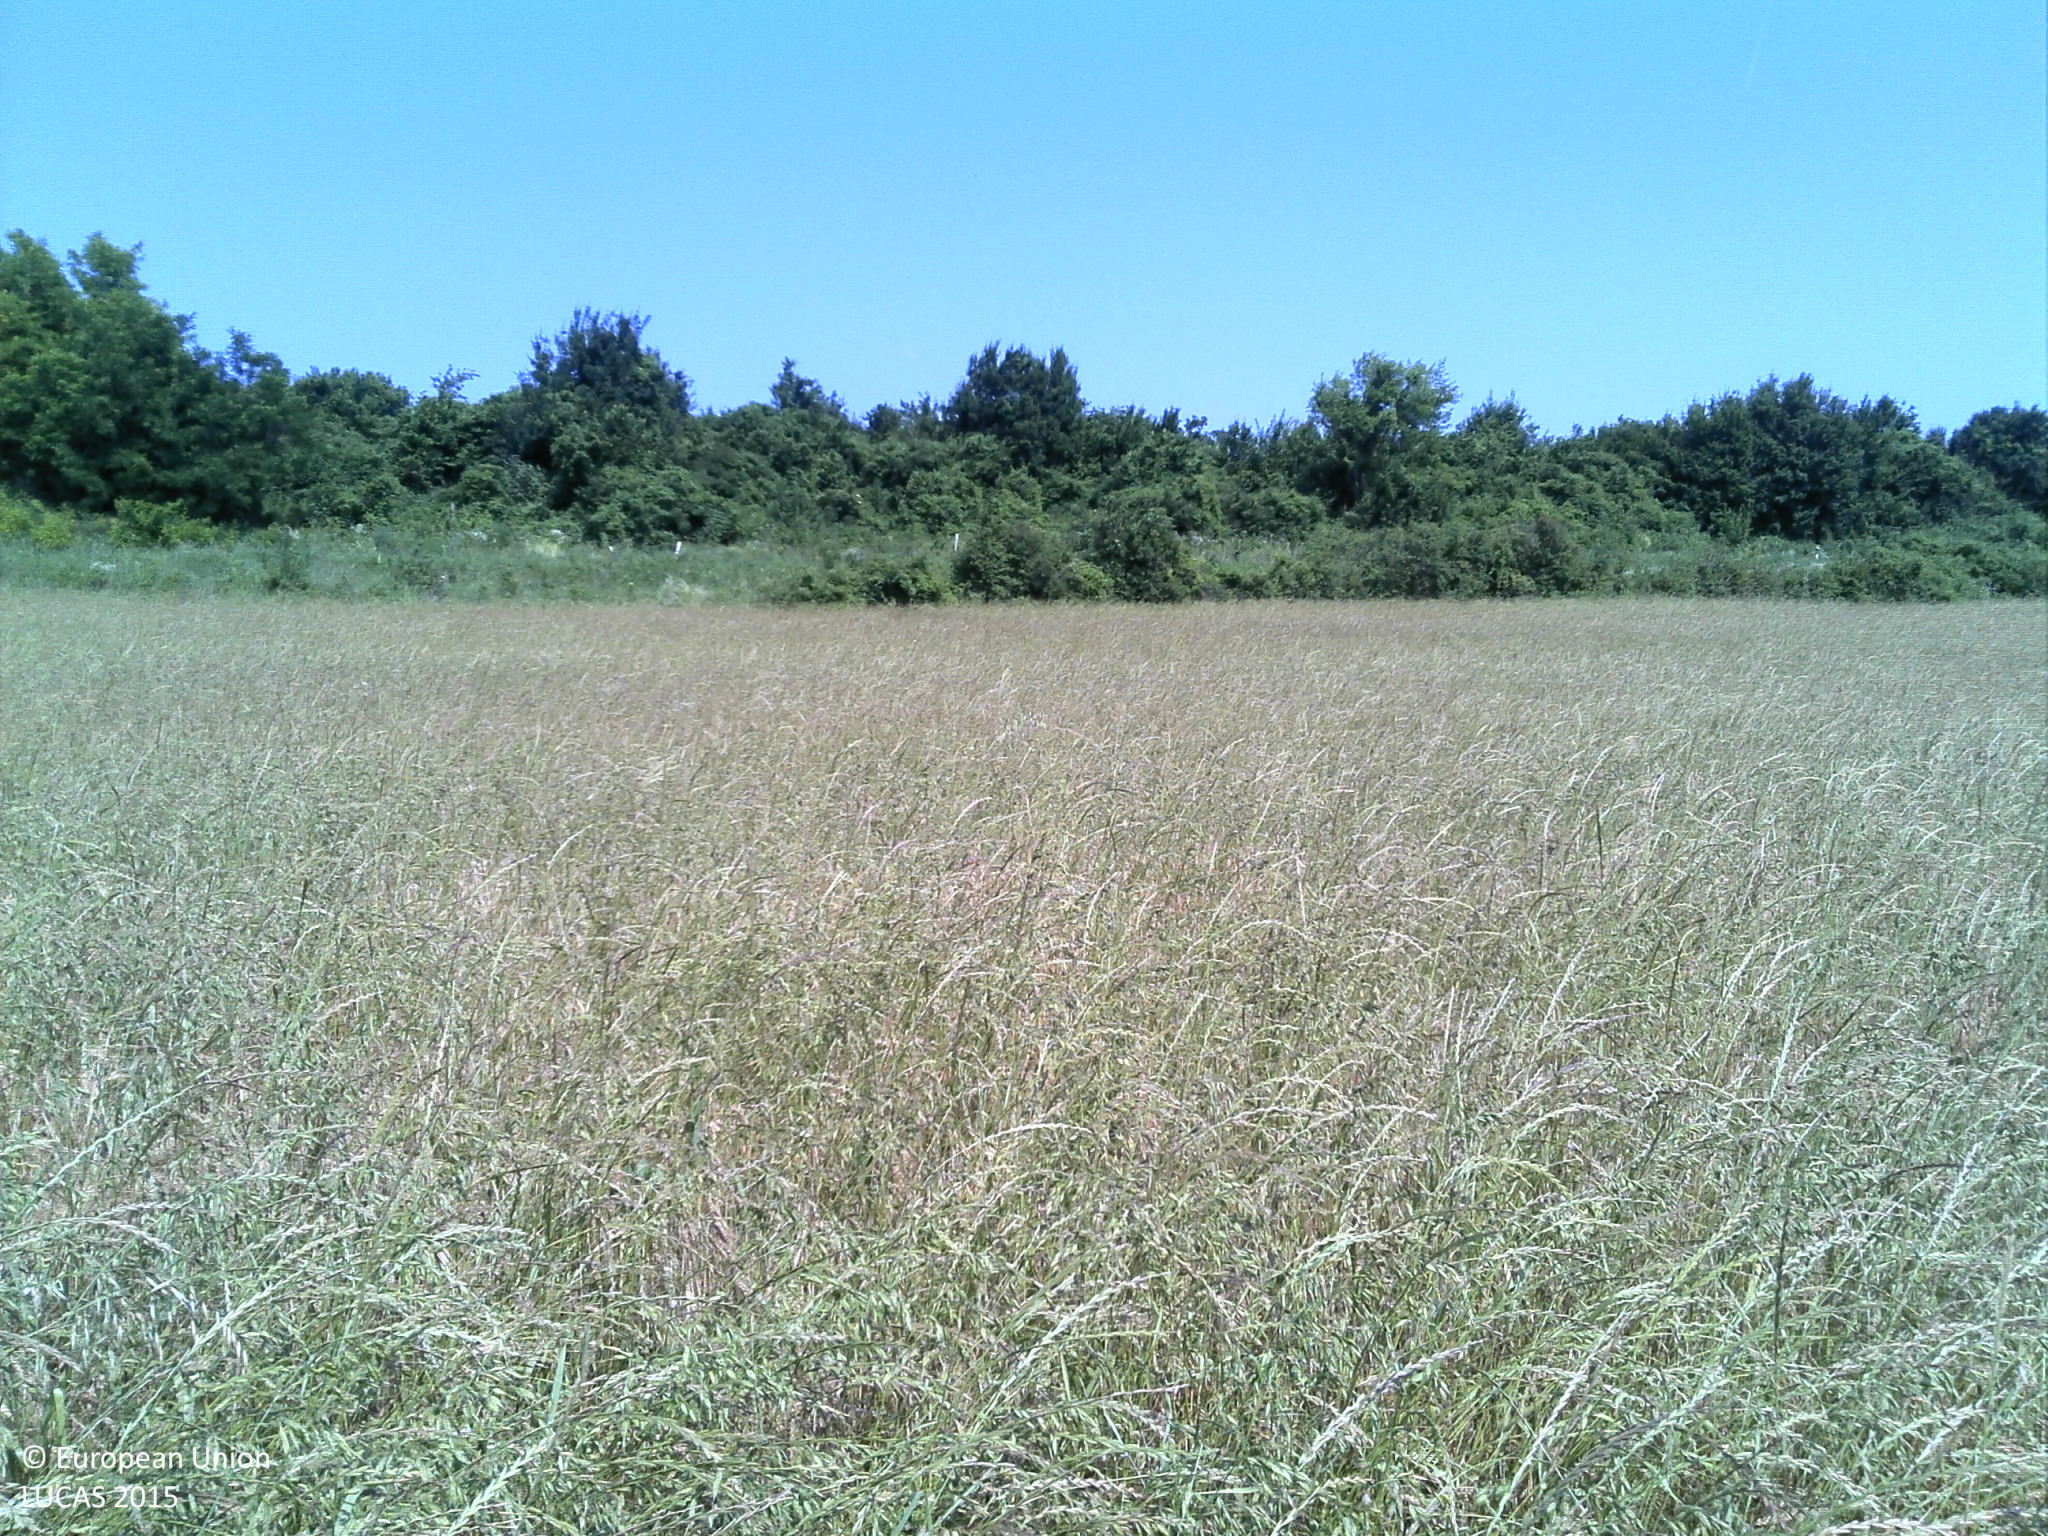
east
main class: Cropland
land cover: Mixed cereals for fodder
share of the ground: > 75 %
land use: Agriculture (excluding fallow land and kitchen gardens)
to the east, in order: Mixed cereals for fodder; Ditches and canals; Tracks; Ditches and canals; Shrubland with sparse tree cover; Barley
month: June
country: HR
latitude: 45.2375
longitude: 17.9897
